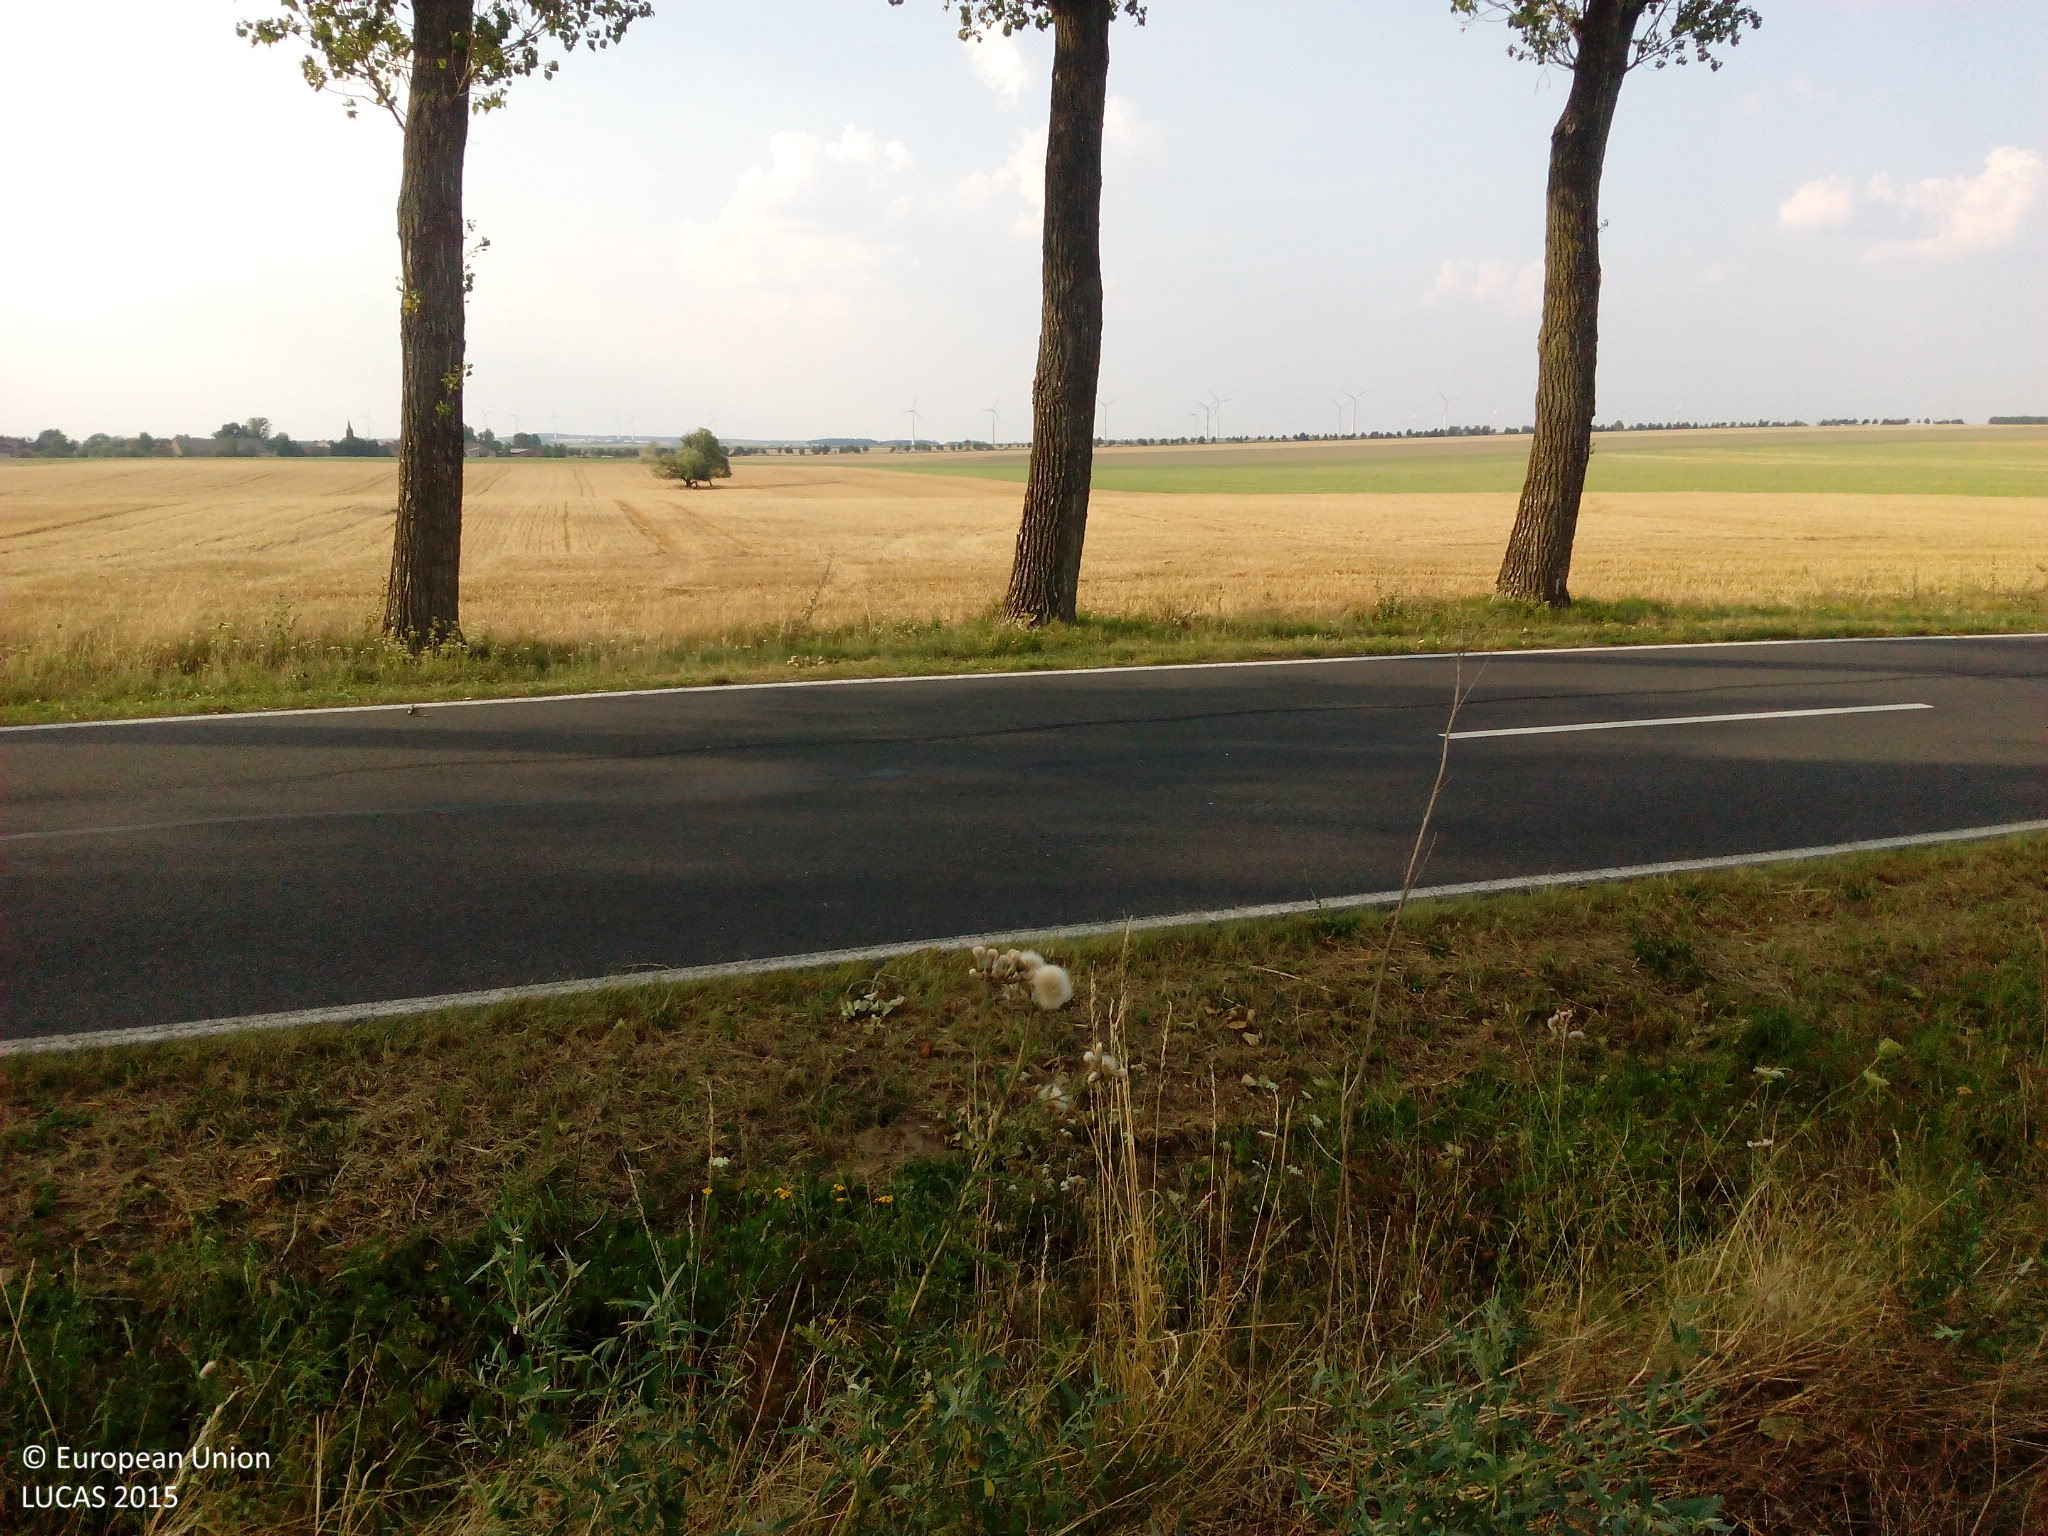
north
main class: Cropland
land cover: Common wheat
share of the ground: > 75 %
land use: Agriculture (excluding fallow land and kitchen gardens)
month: August
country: DE
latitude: 51.9039
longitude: 13.1541
